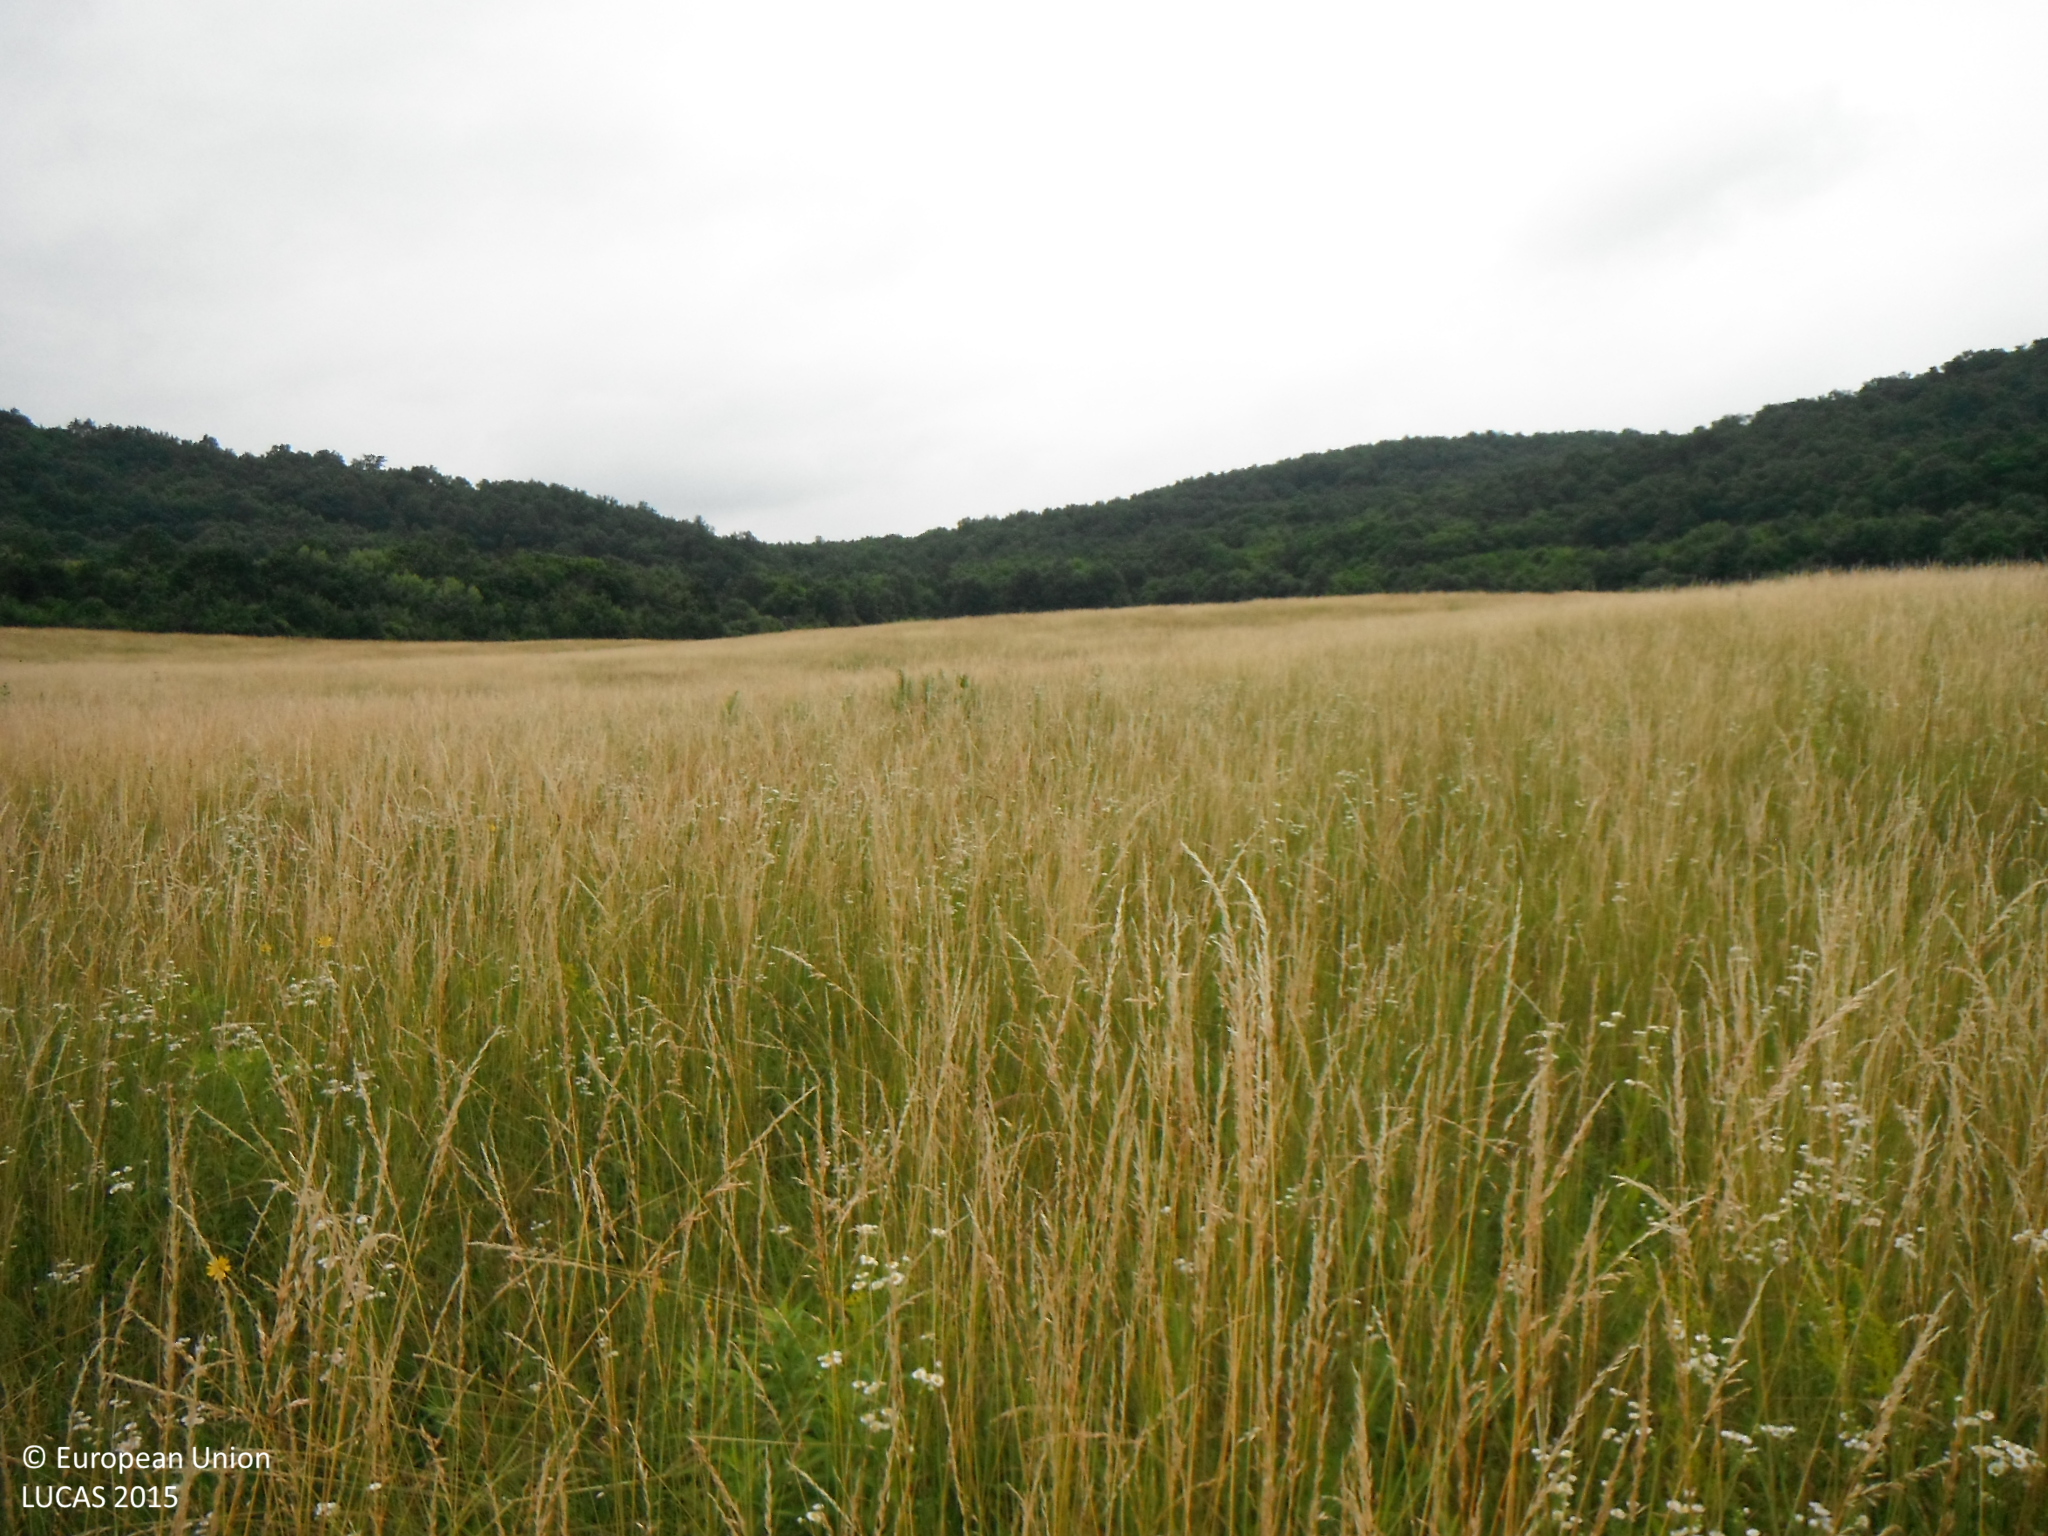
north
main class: Grassland
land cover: Grassland without tree/shrub cover
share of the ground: > 75 %
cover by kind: herbaceous plants 100 %
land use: Agriculture (excluding fallow land and kitchen gardens)
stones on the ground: < 10 %
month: June
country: SK
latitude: 48.5007
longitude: 20.1135
